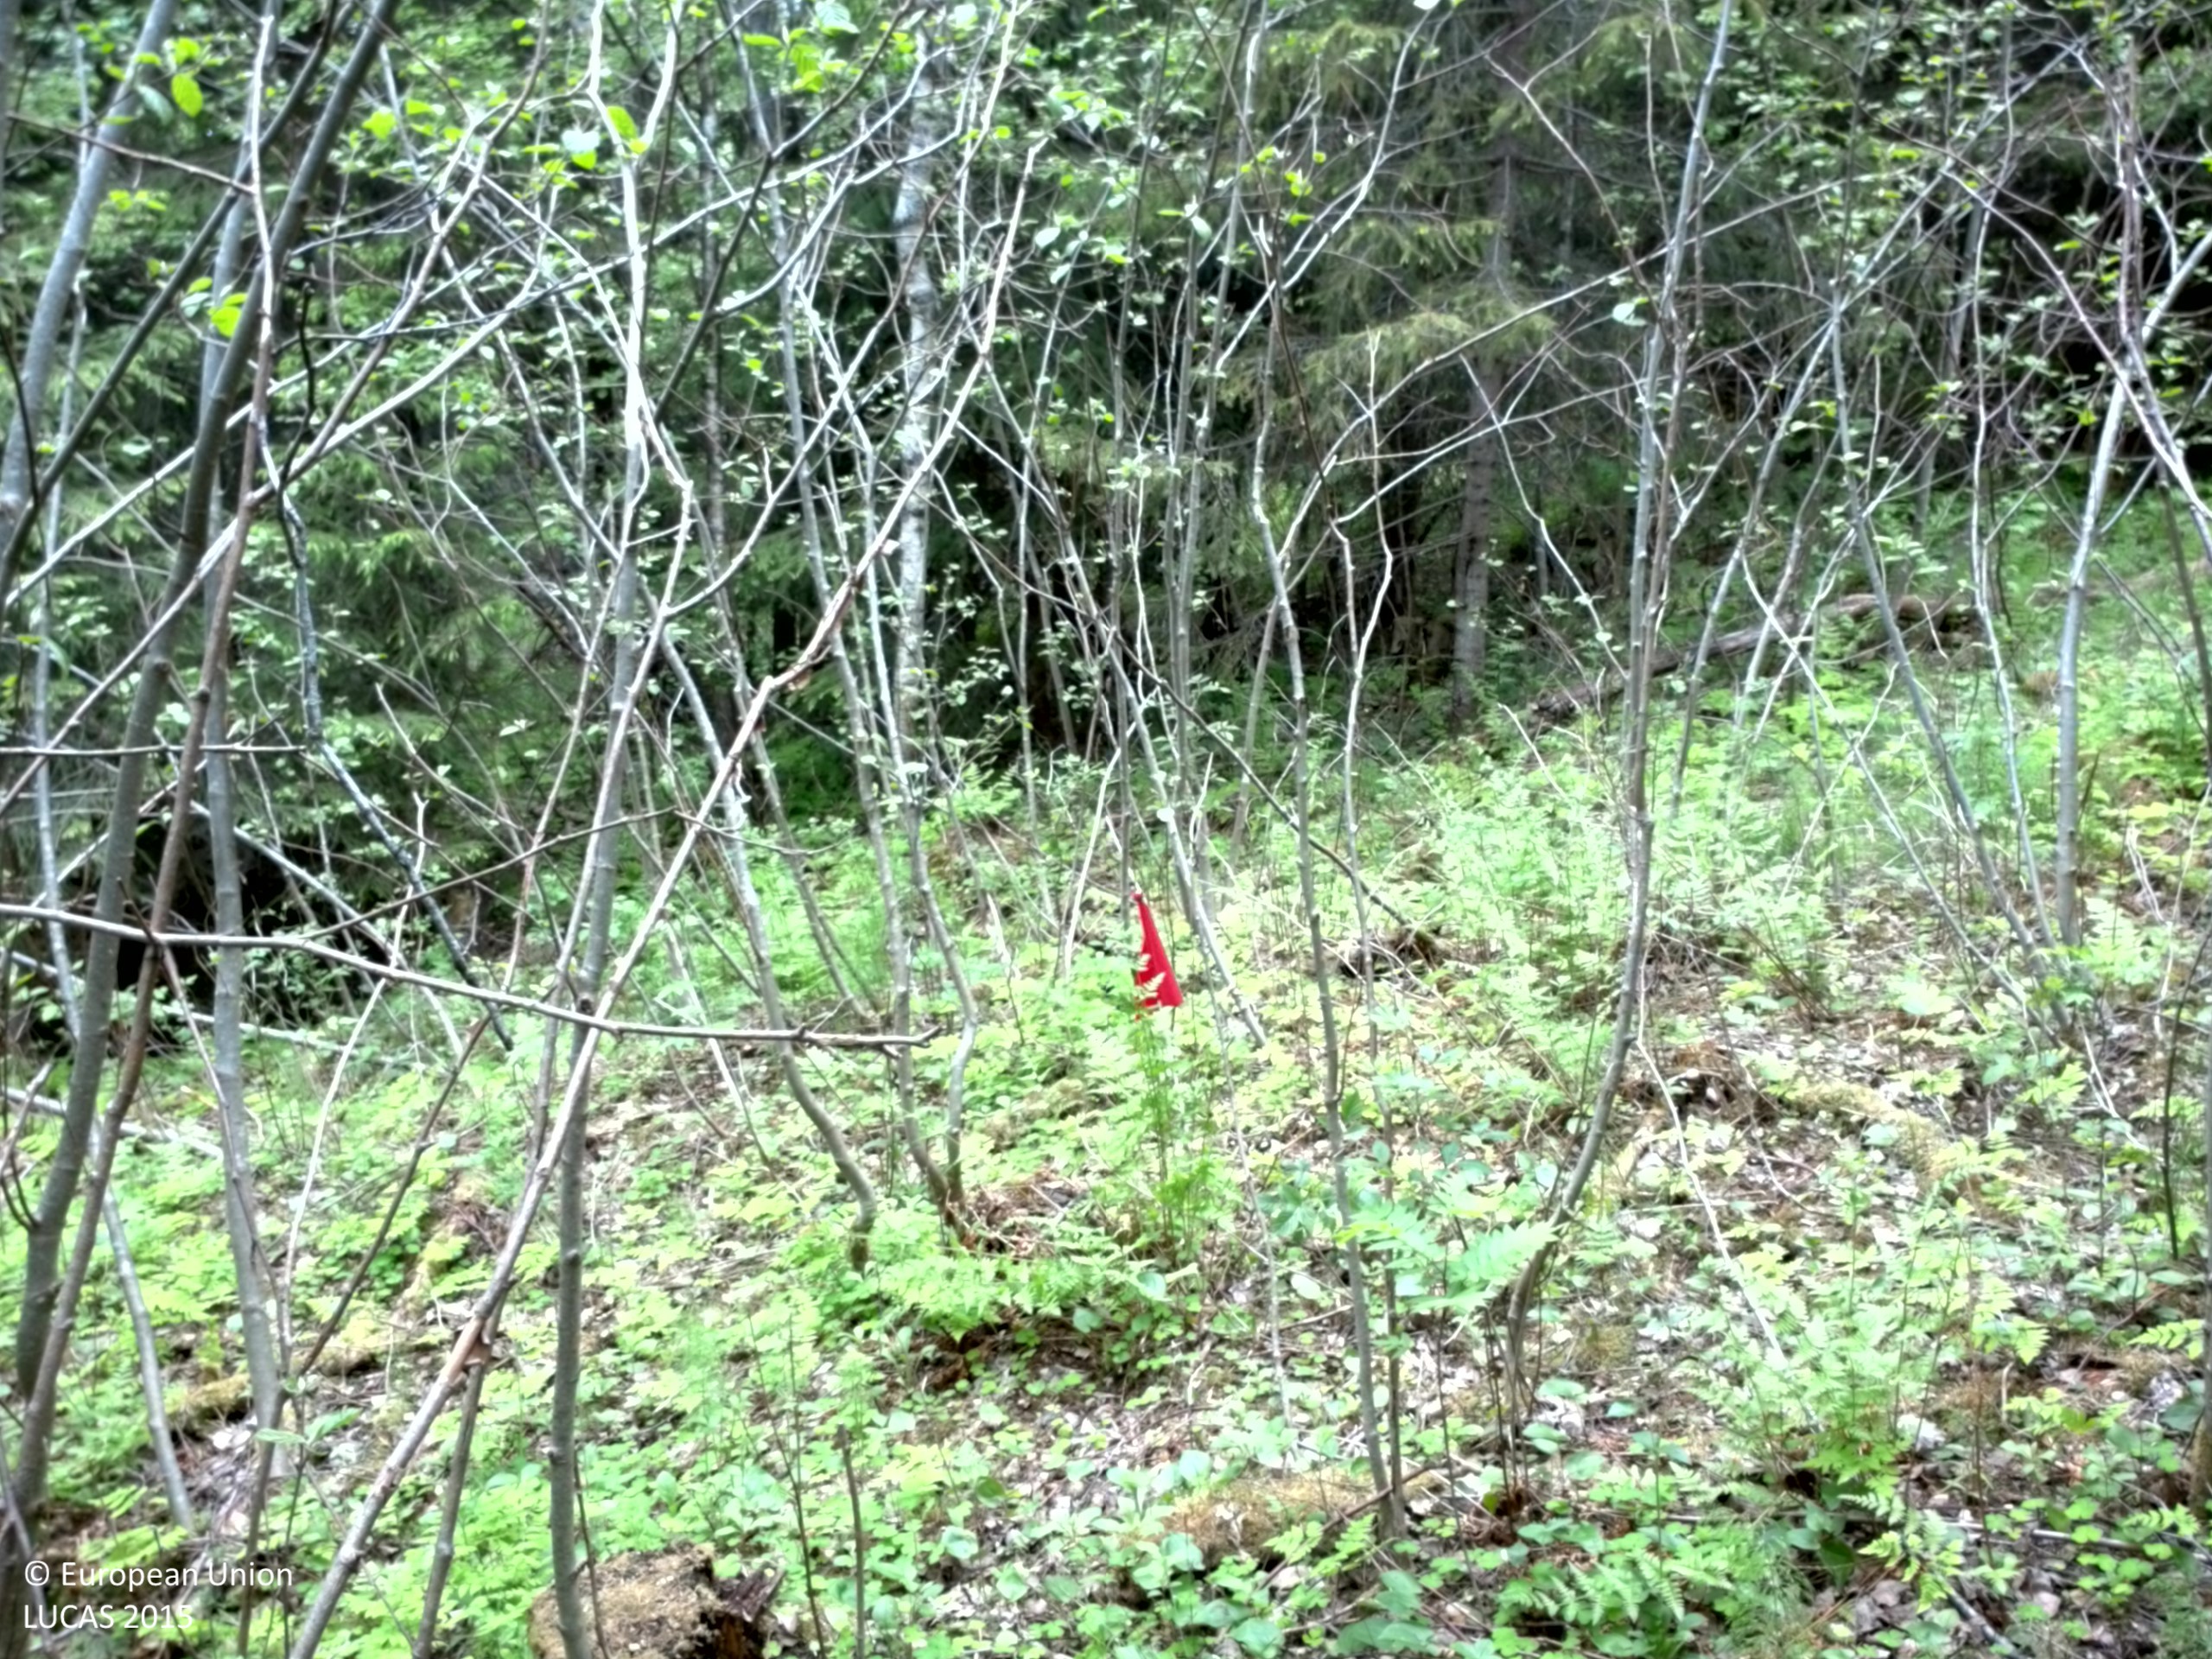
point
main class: Woodland
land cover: Other mixed woodland
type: boreal forest
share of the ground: > 75 %
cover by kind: broadleaved forest trees 60 %, coniferous forest trees 30 %, herbaceous plants 10 %
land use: Forestry
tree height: > 5 m
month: June
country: SE
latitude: 63.1030
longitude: 17.7239
